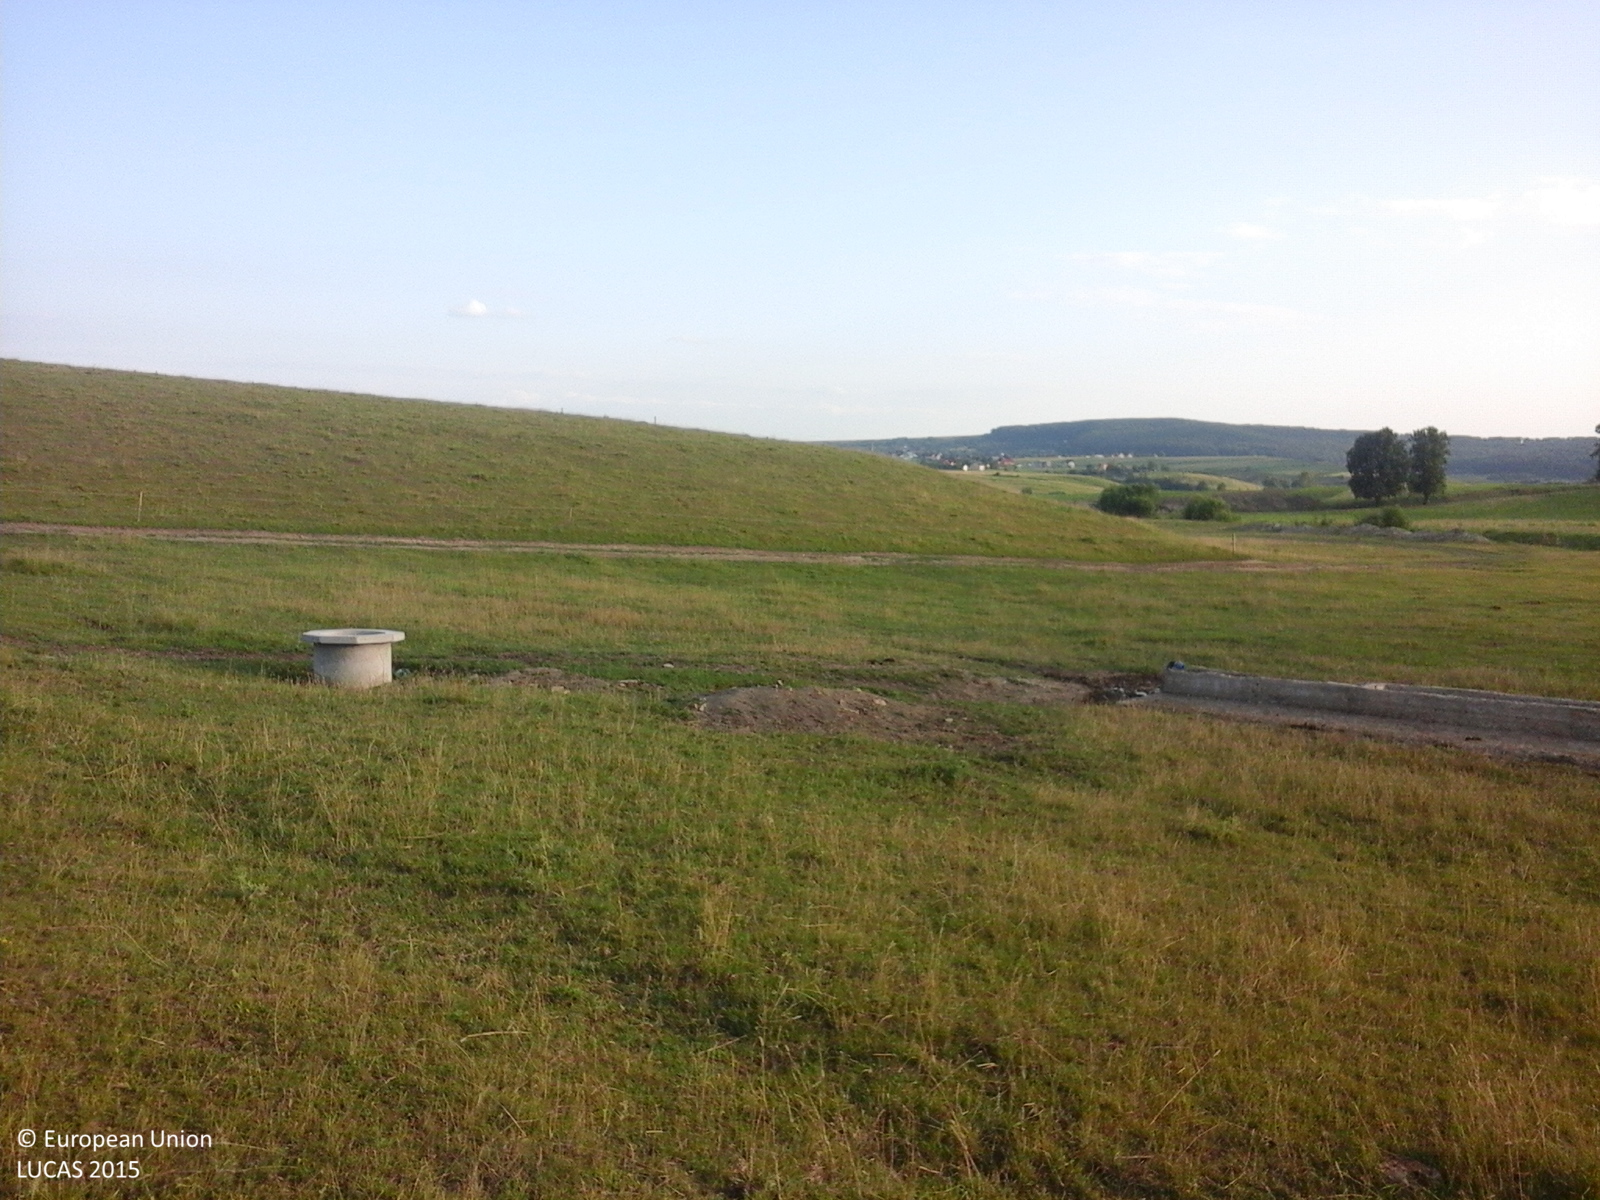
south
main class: Grassland
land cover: Grassland without tree/shrub cover
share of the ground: > 75 %
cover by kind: herbaceous plants 100 %
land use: Agriculture (excluding fallow land and kitchen gardens)
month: June
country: RO
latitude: 47.7708
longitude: 26.2978
